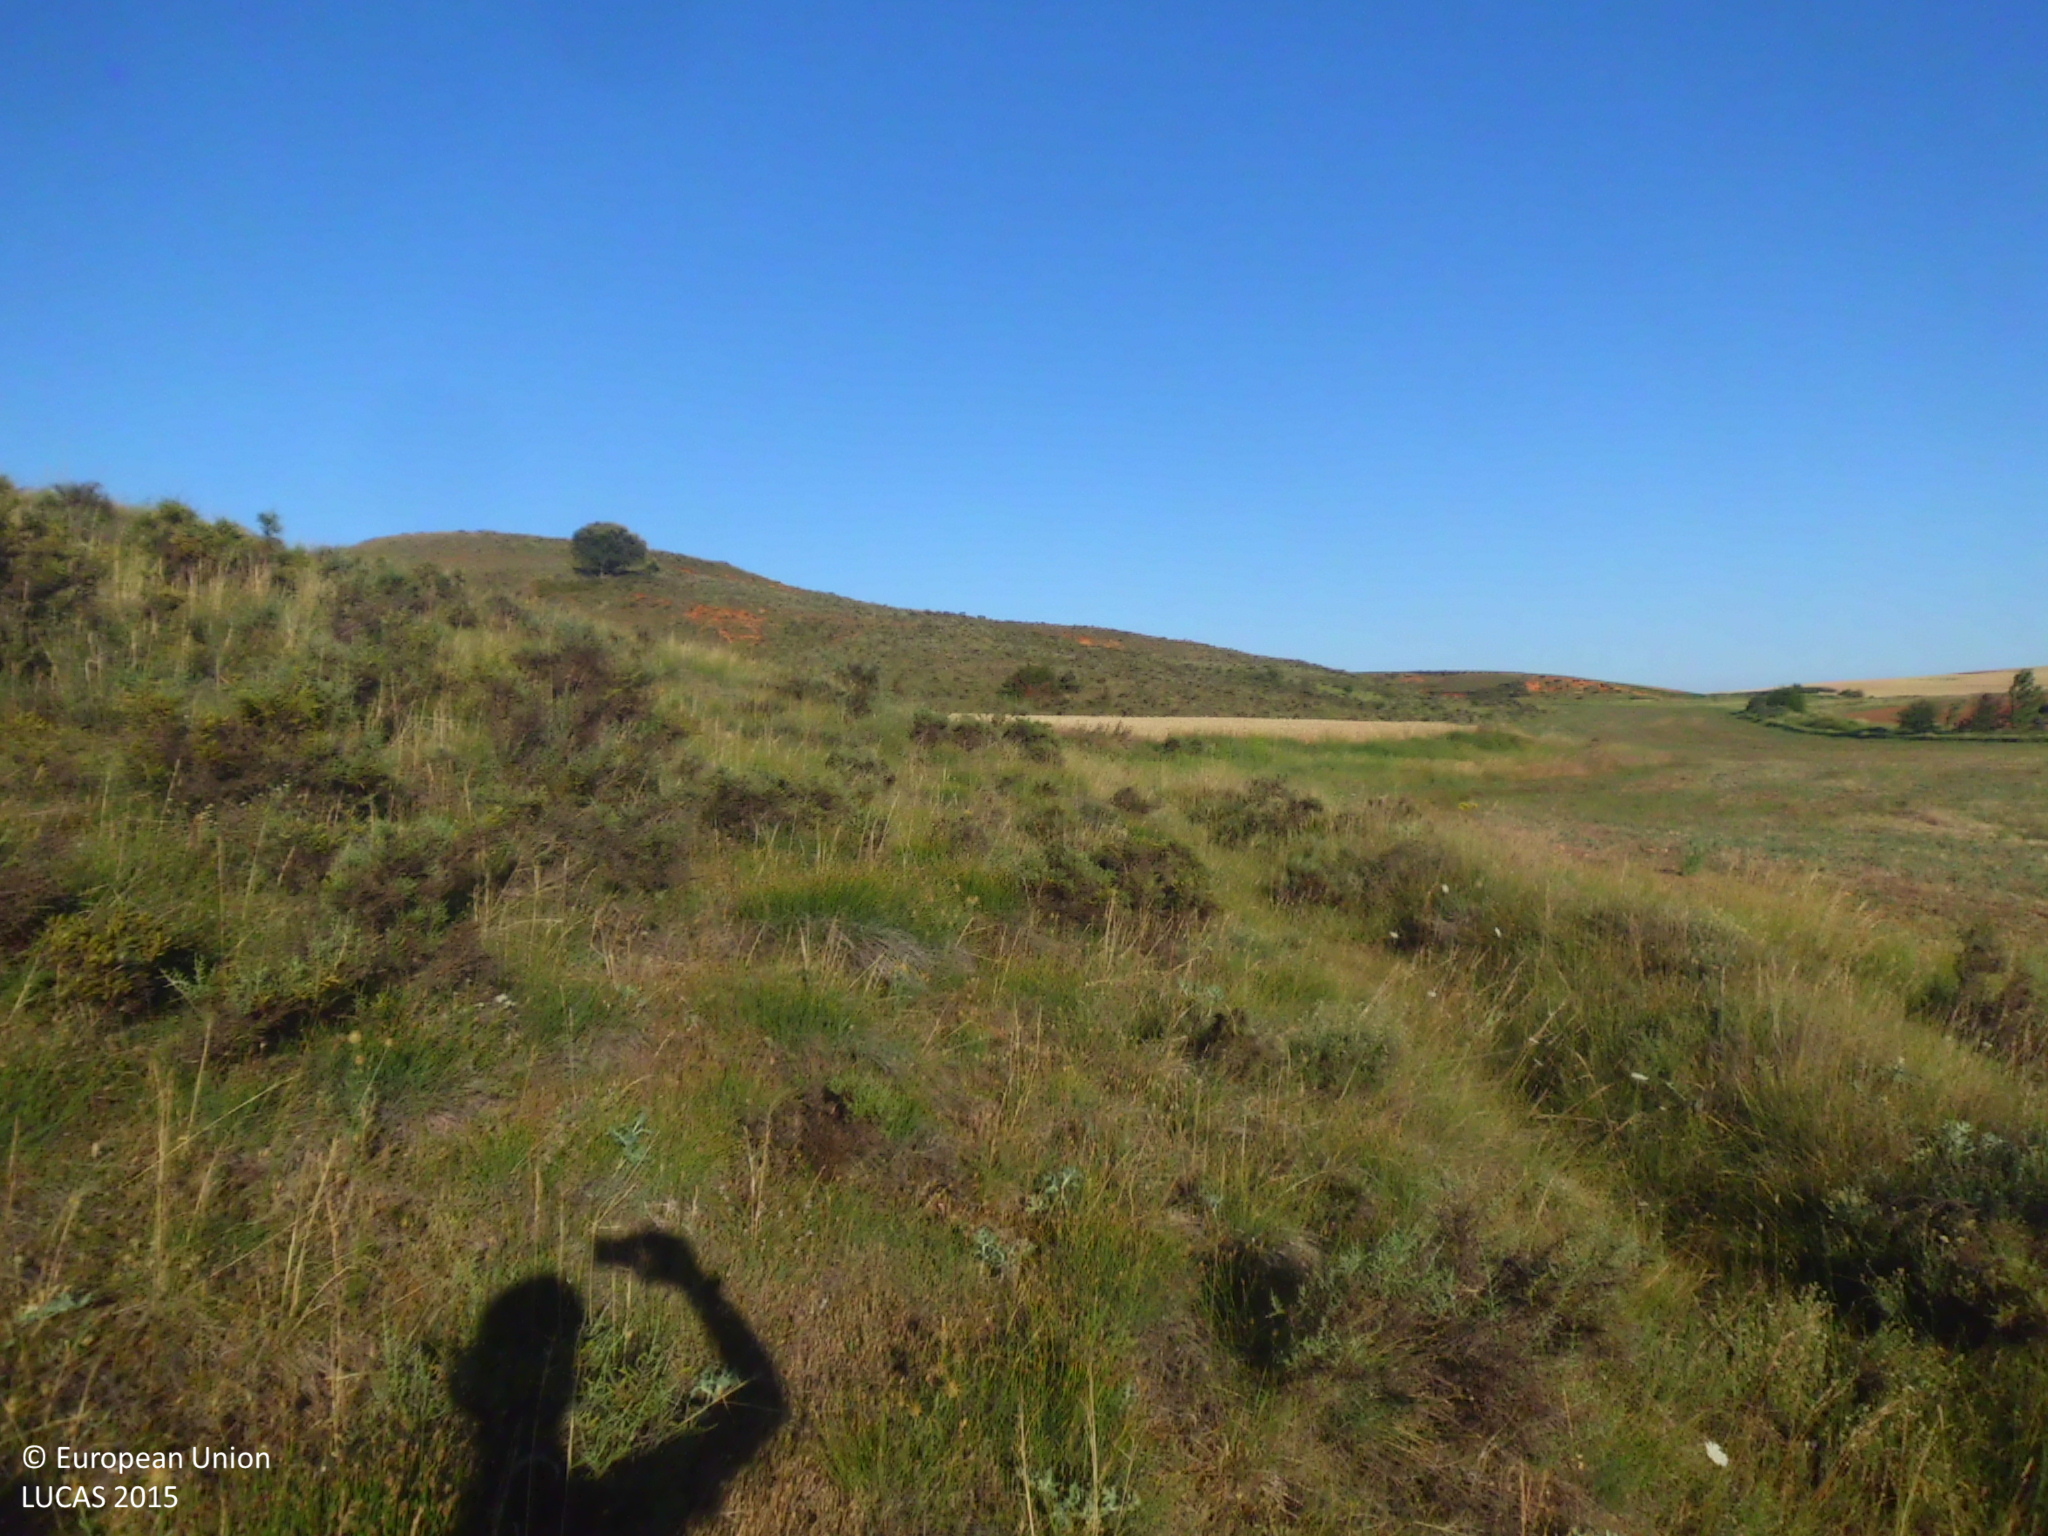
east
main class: Shrubland
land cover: Shrubland without tree cover
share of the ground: 50 - 75 %
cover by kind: shrubs 60 %, herbaceous plants 30 %, consolidated bare surface 10 %
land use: Semi-natural and natural areas not in use
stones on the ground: 25 - 50 %
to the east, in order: Shrubland without tree cover; Common wheat; Shrubland without tree cover; Common wheat
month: July
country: ES
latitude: 42.6287
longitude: -4.2537
